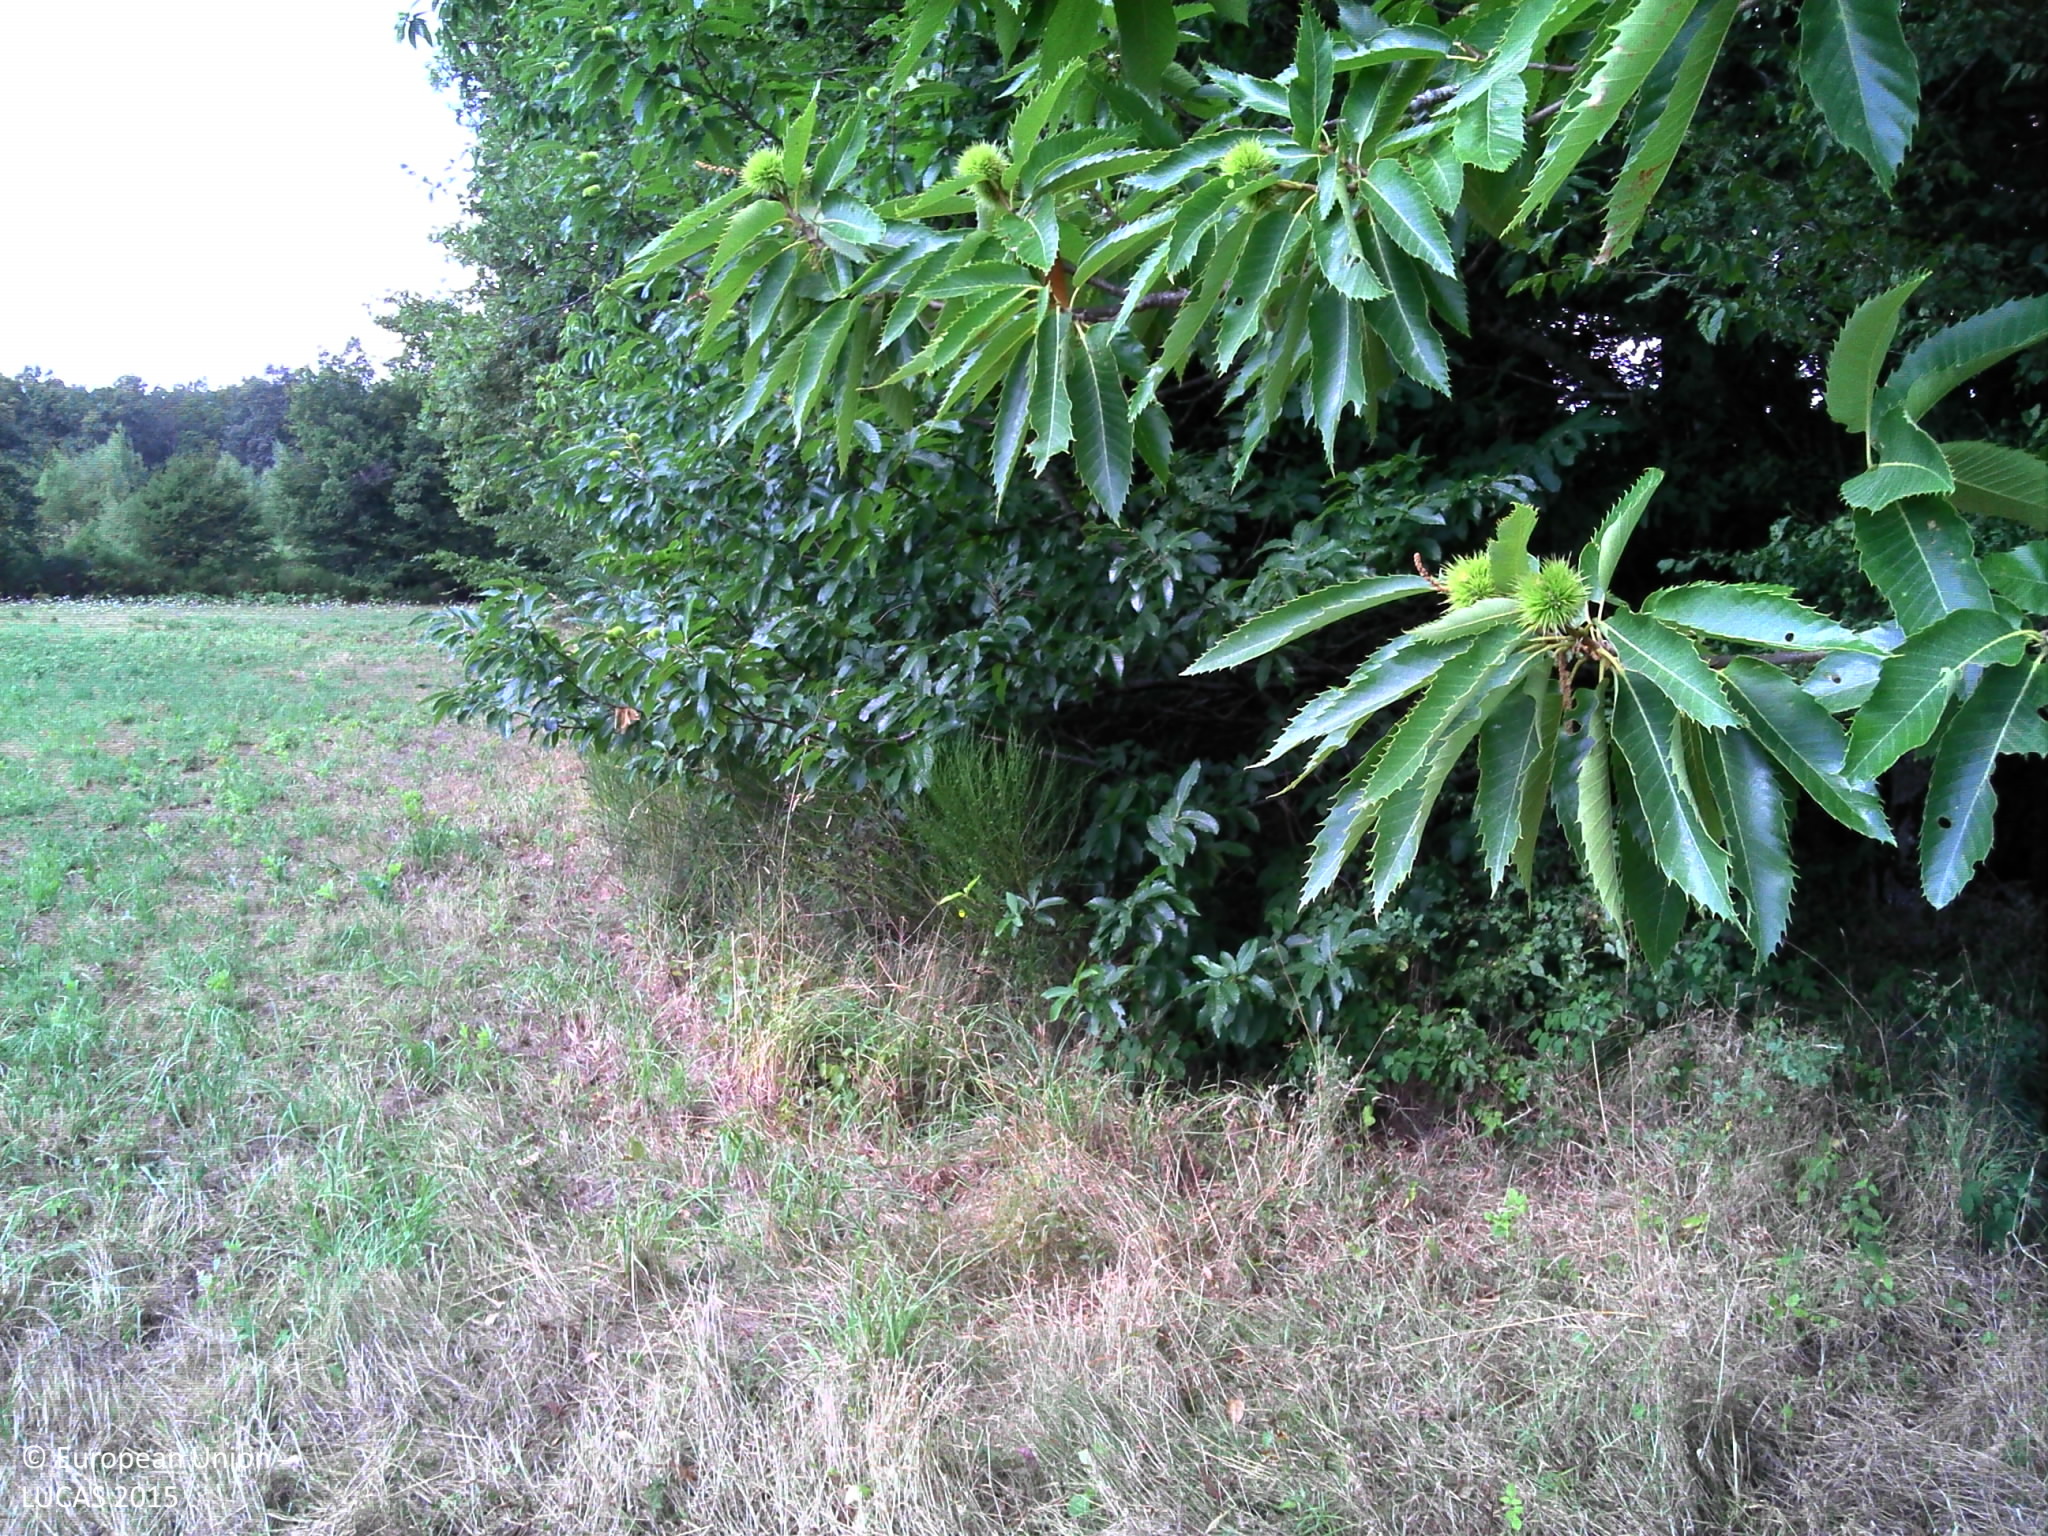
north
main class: Grassland
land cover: Spontaneously vegetated surfaces
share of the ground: > 75 %
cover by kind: herbaceous plants 100 %
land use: Fallow land
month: July
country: FR
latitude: 47.5785
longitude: 3.1744
